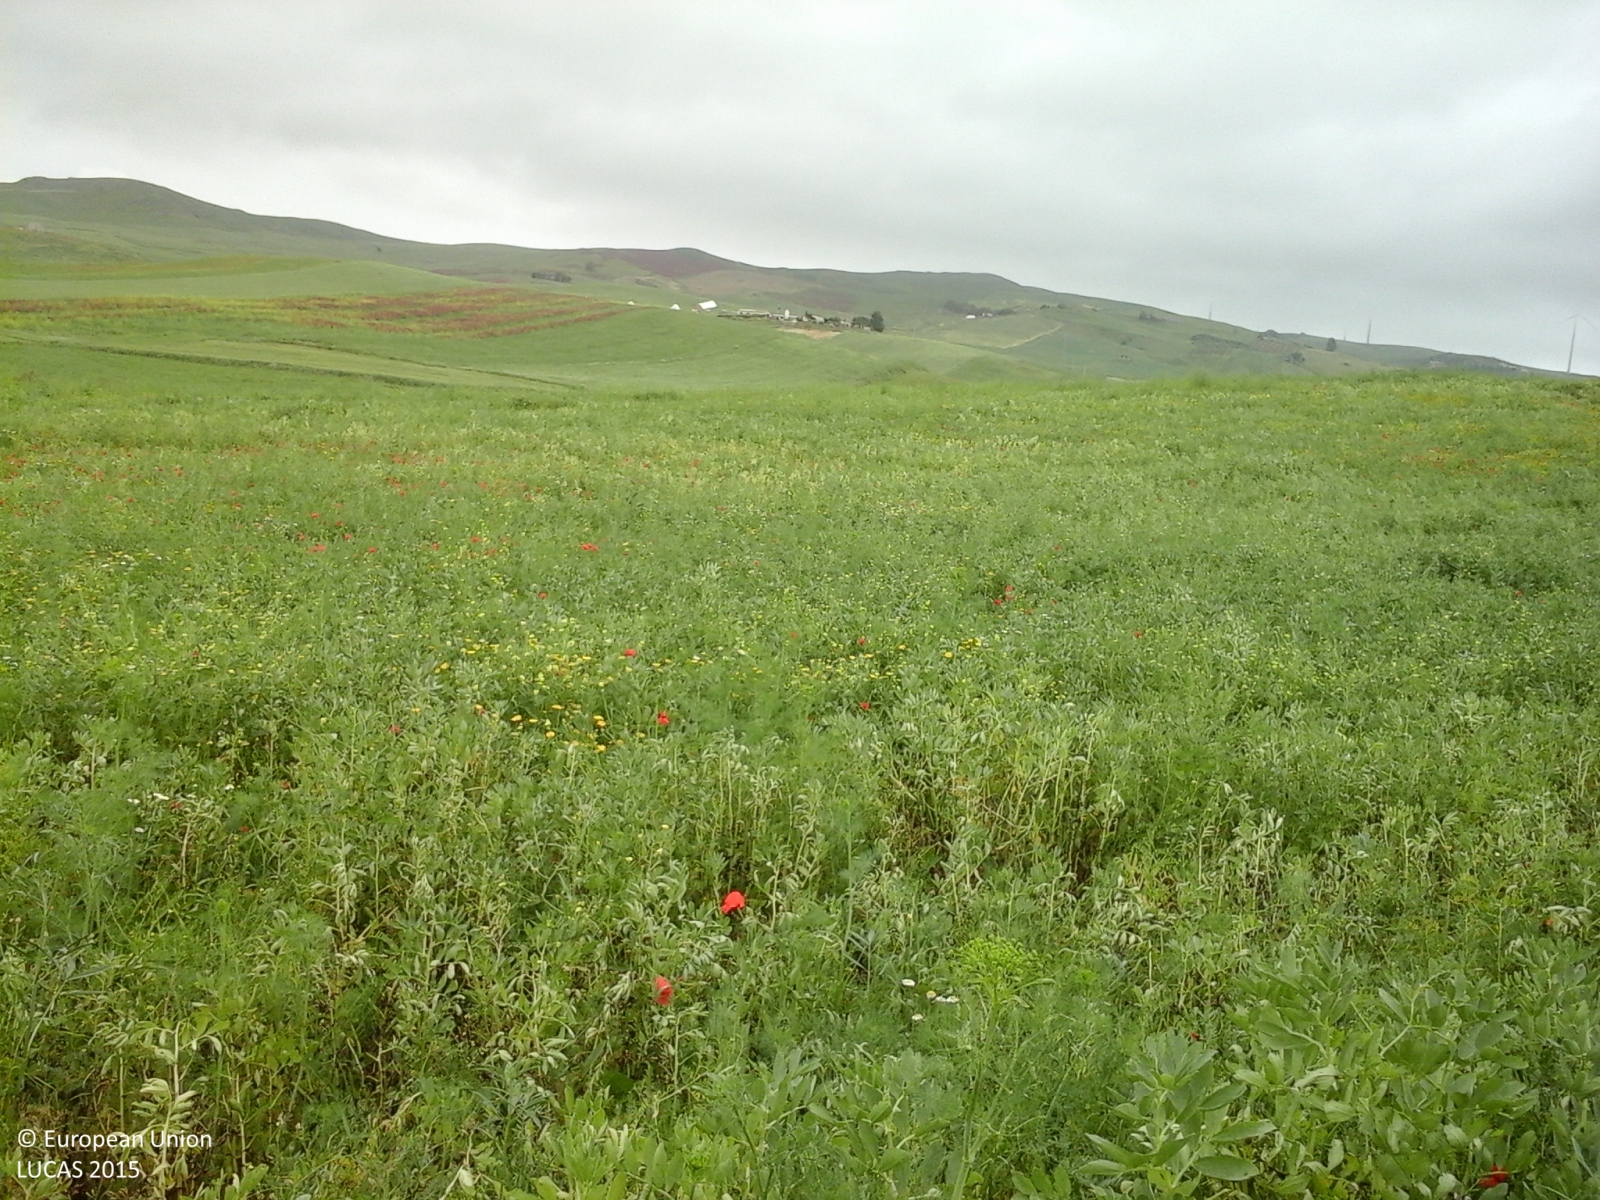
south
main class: Cropland
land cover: Temporary grasslands
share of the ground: > 75 %
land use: Agriculture (excluding fallow land and kitchen gardens)
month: May
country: IT
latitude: 37.7126
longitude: 13.6824
